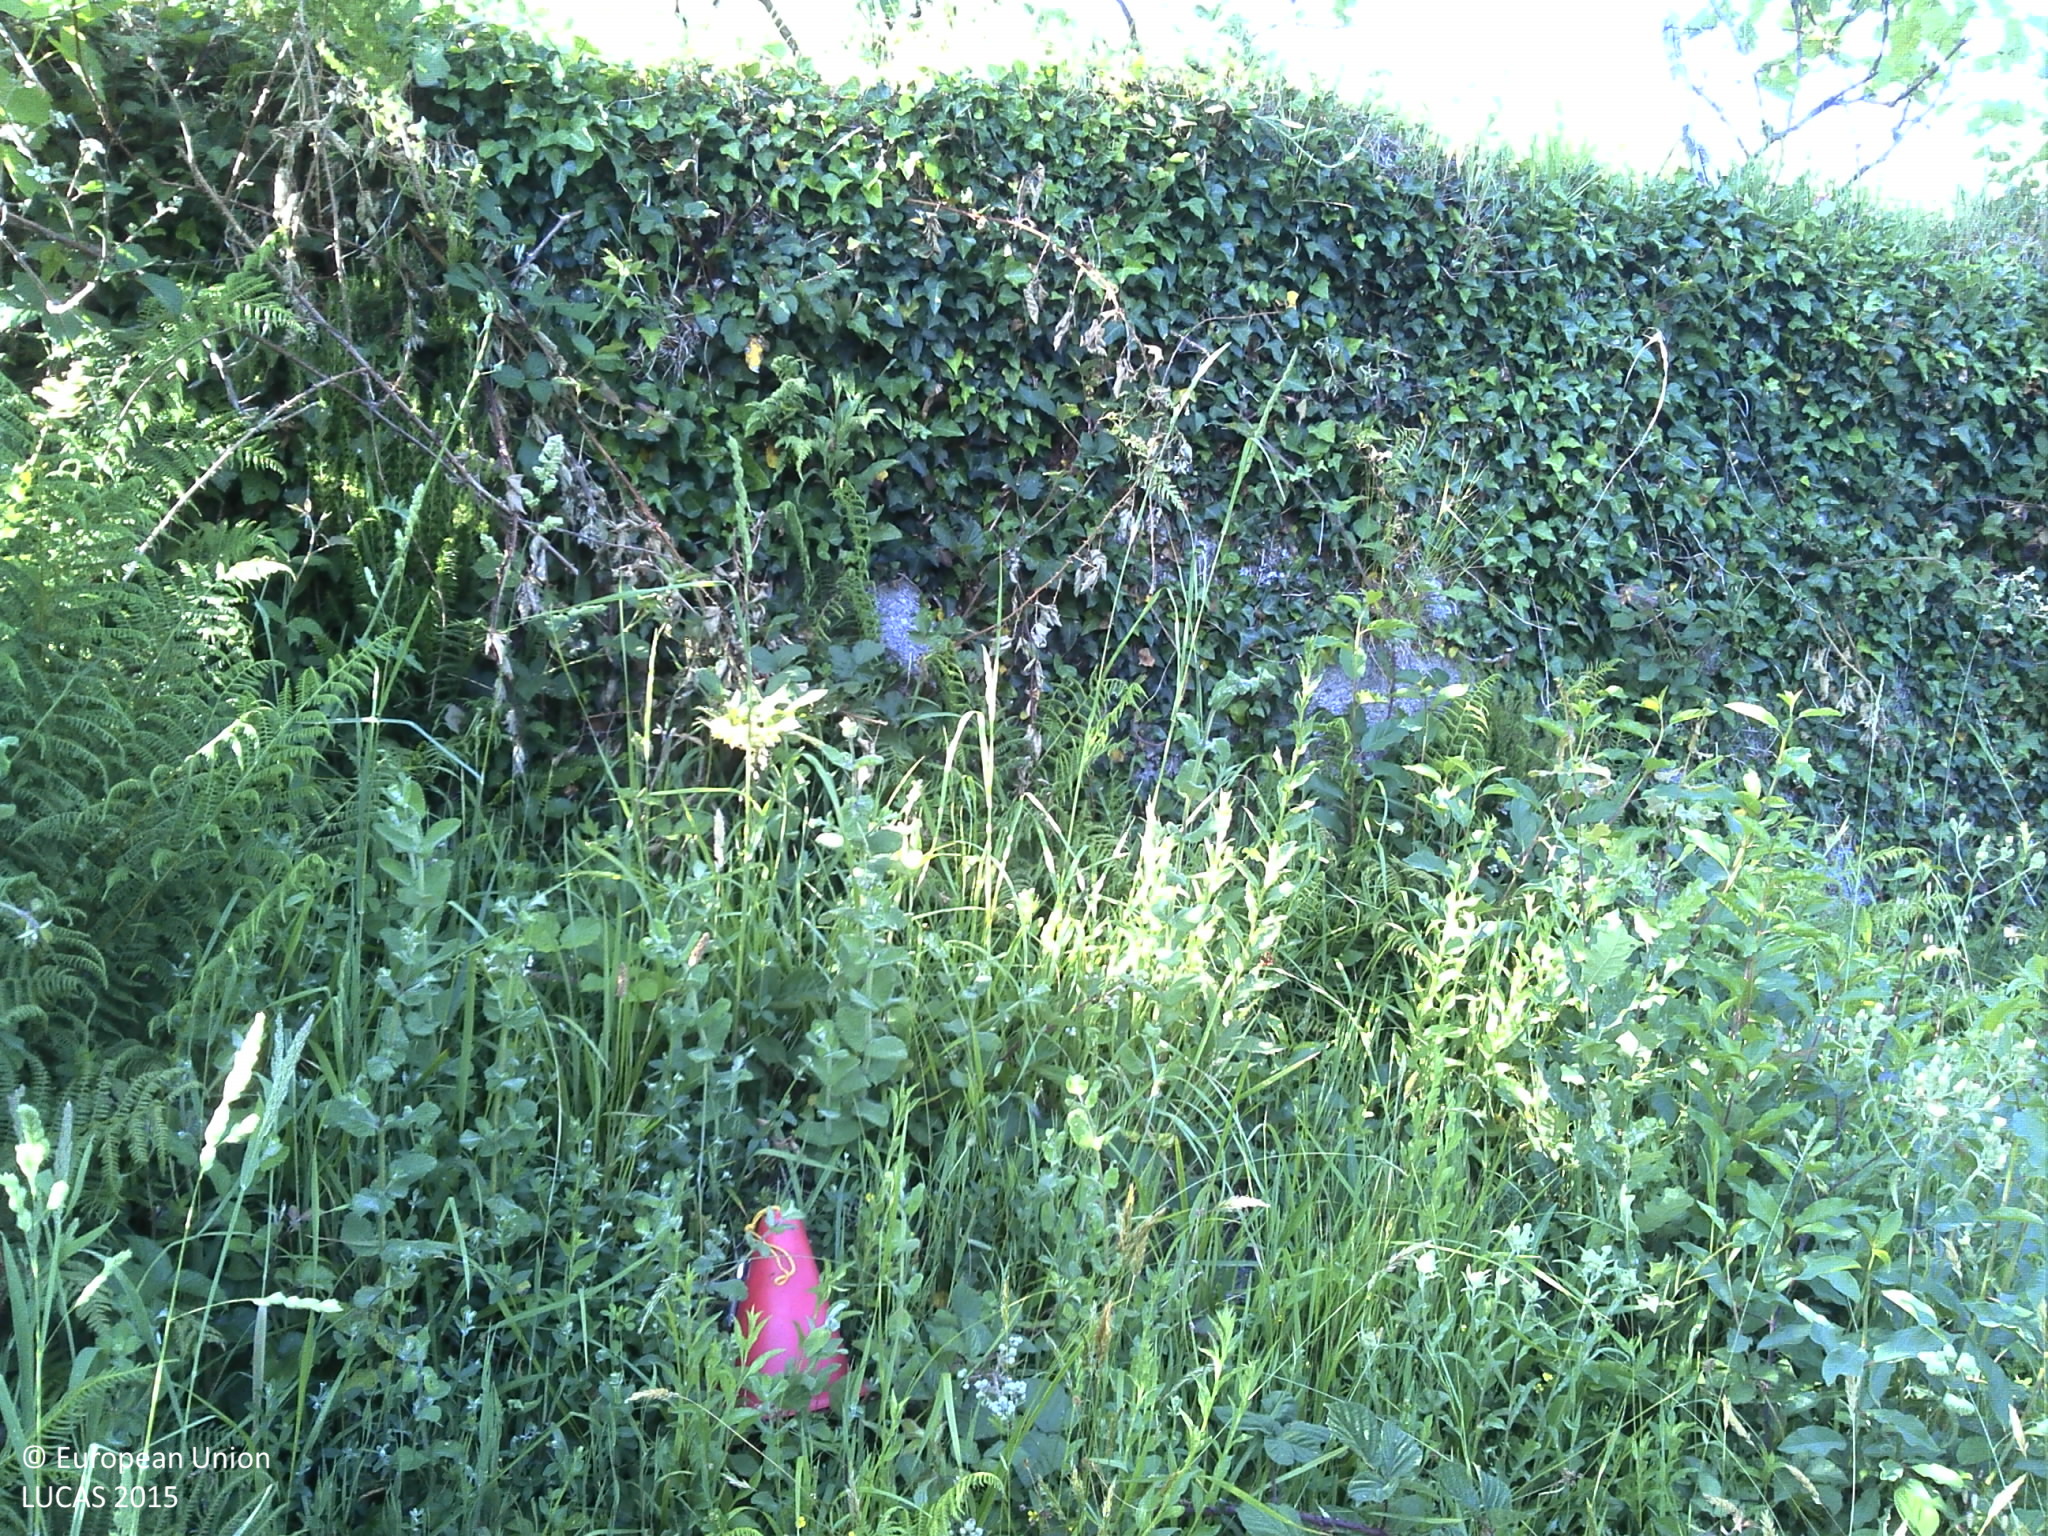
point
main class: Grassland
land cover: Grassland without tree/shrub cover
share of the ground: > 75 %
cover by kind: herbaceous plants 90 %, shrubs 5 %, unconsolidated bare surface 5 %
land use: Agriculture (excluding fallow land and kitchen gardens)
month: June
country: PT
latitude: 41.9510
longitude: -8.1883
